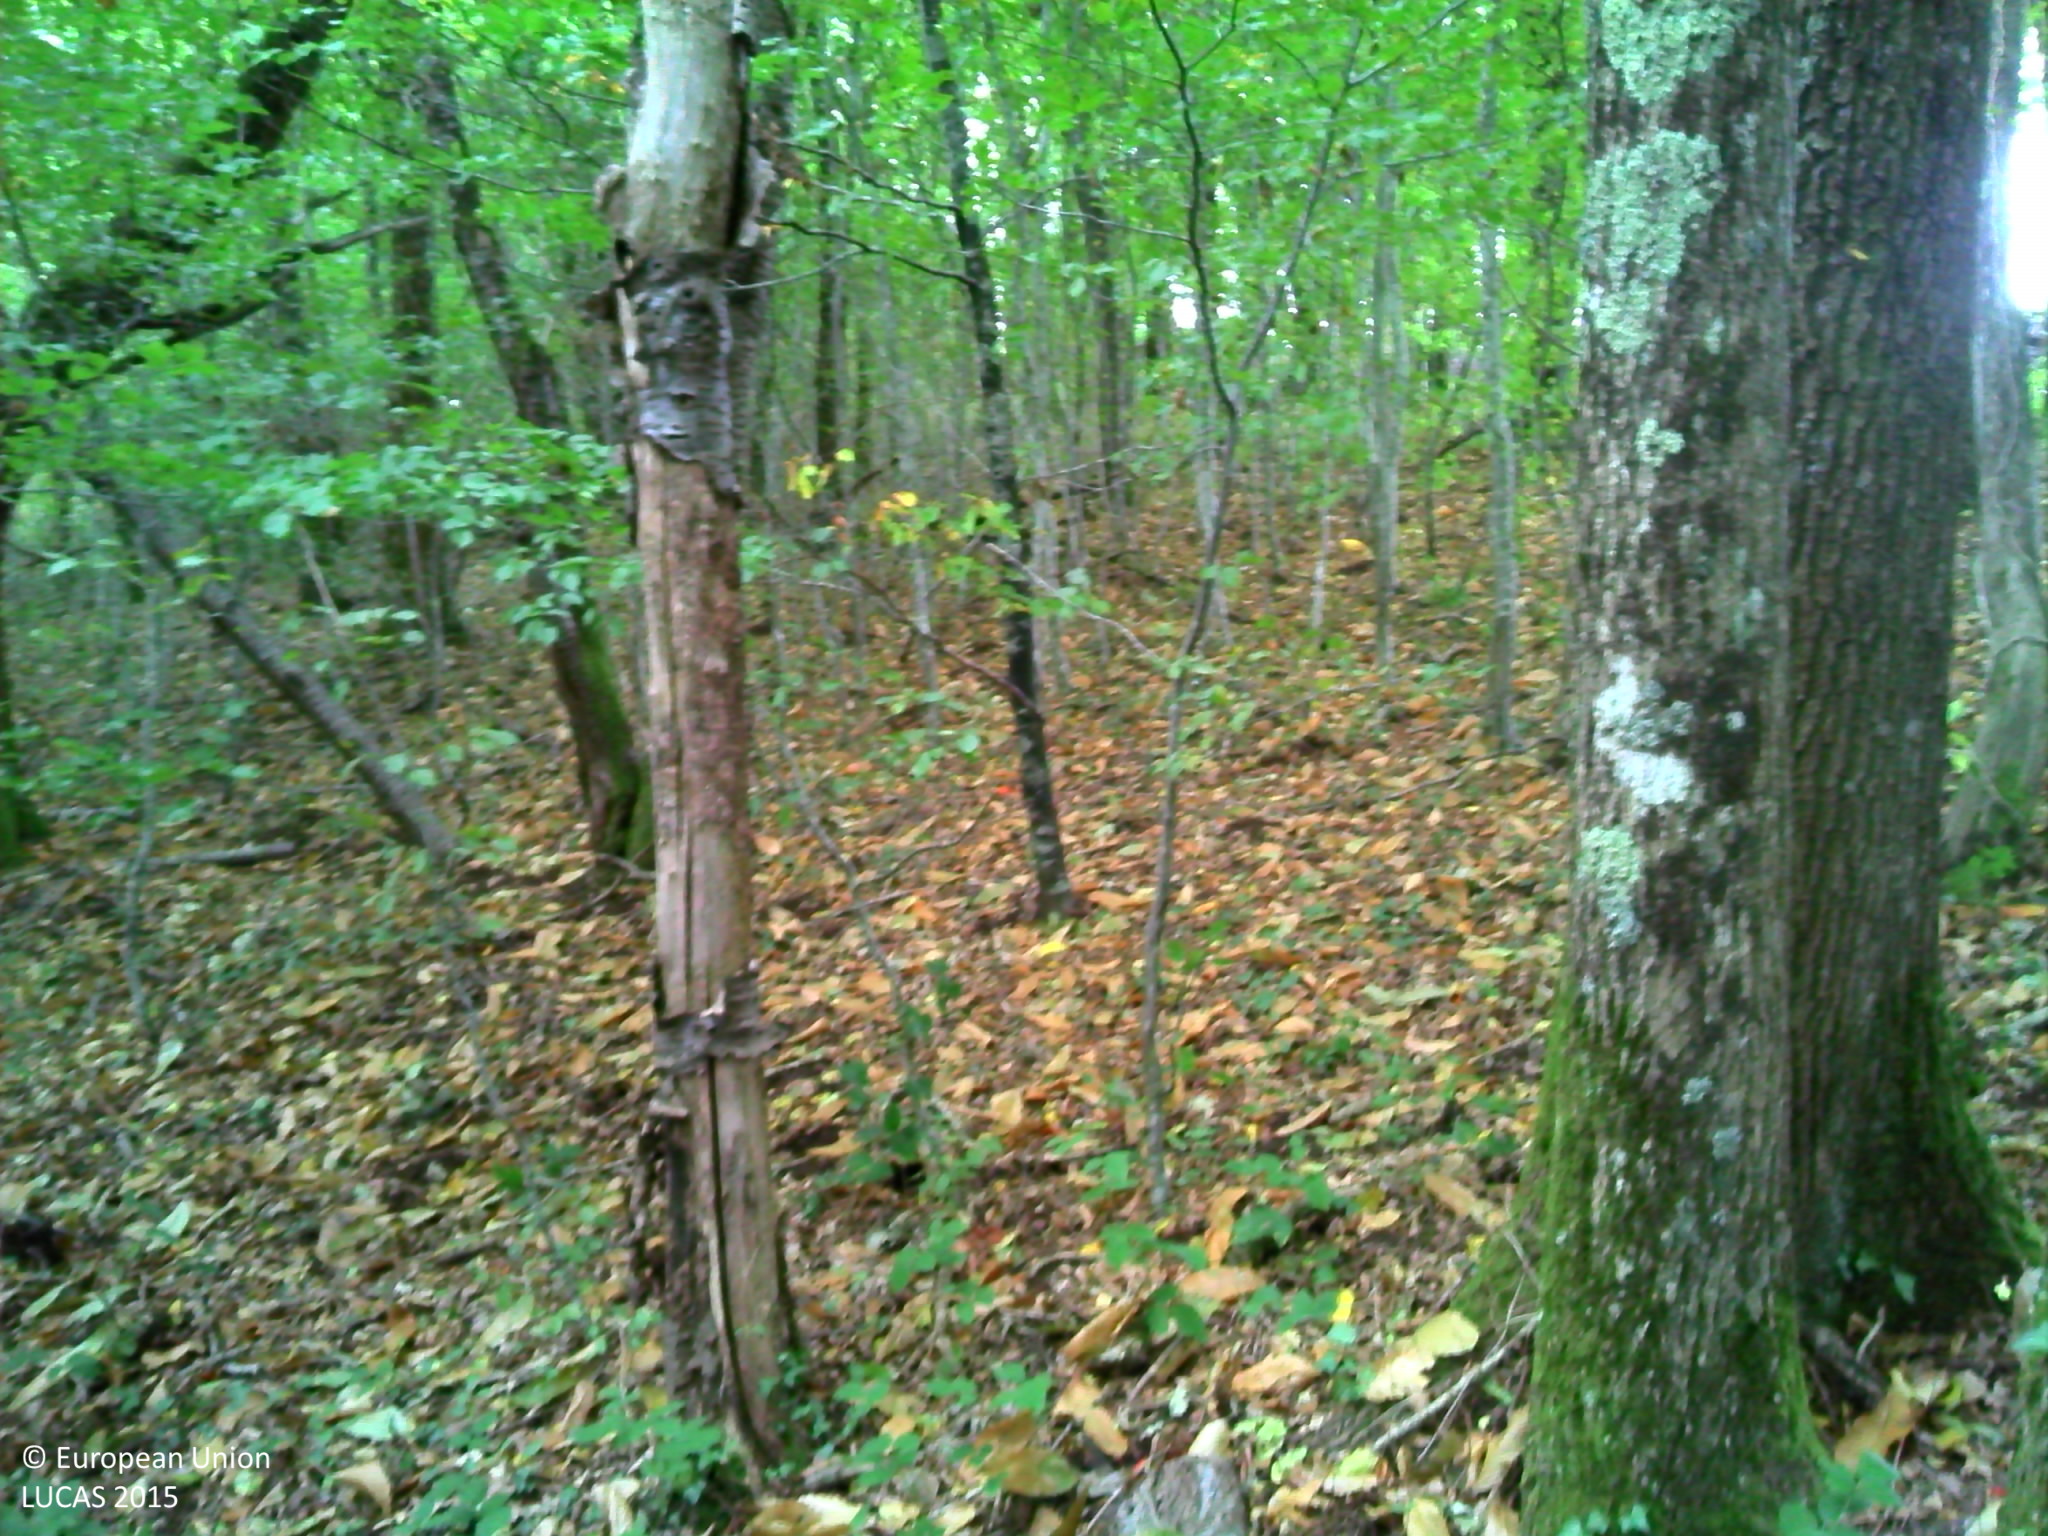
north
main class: Woodland
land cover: Broadleaved woodland
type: mesophytic deciduous forest
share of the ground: > 75 %
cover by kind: broadleaved forest trees 85 %, unconsolidated bare surface 10 %, herbaceous plants 5 %
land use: Forestry
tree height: > 5 m
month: September
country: FR
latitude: 46.4206
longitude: 1.6245
